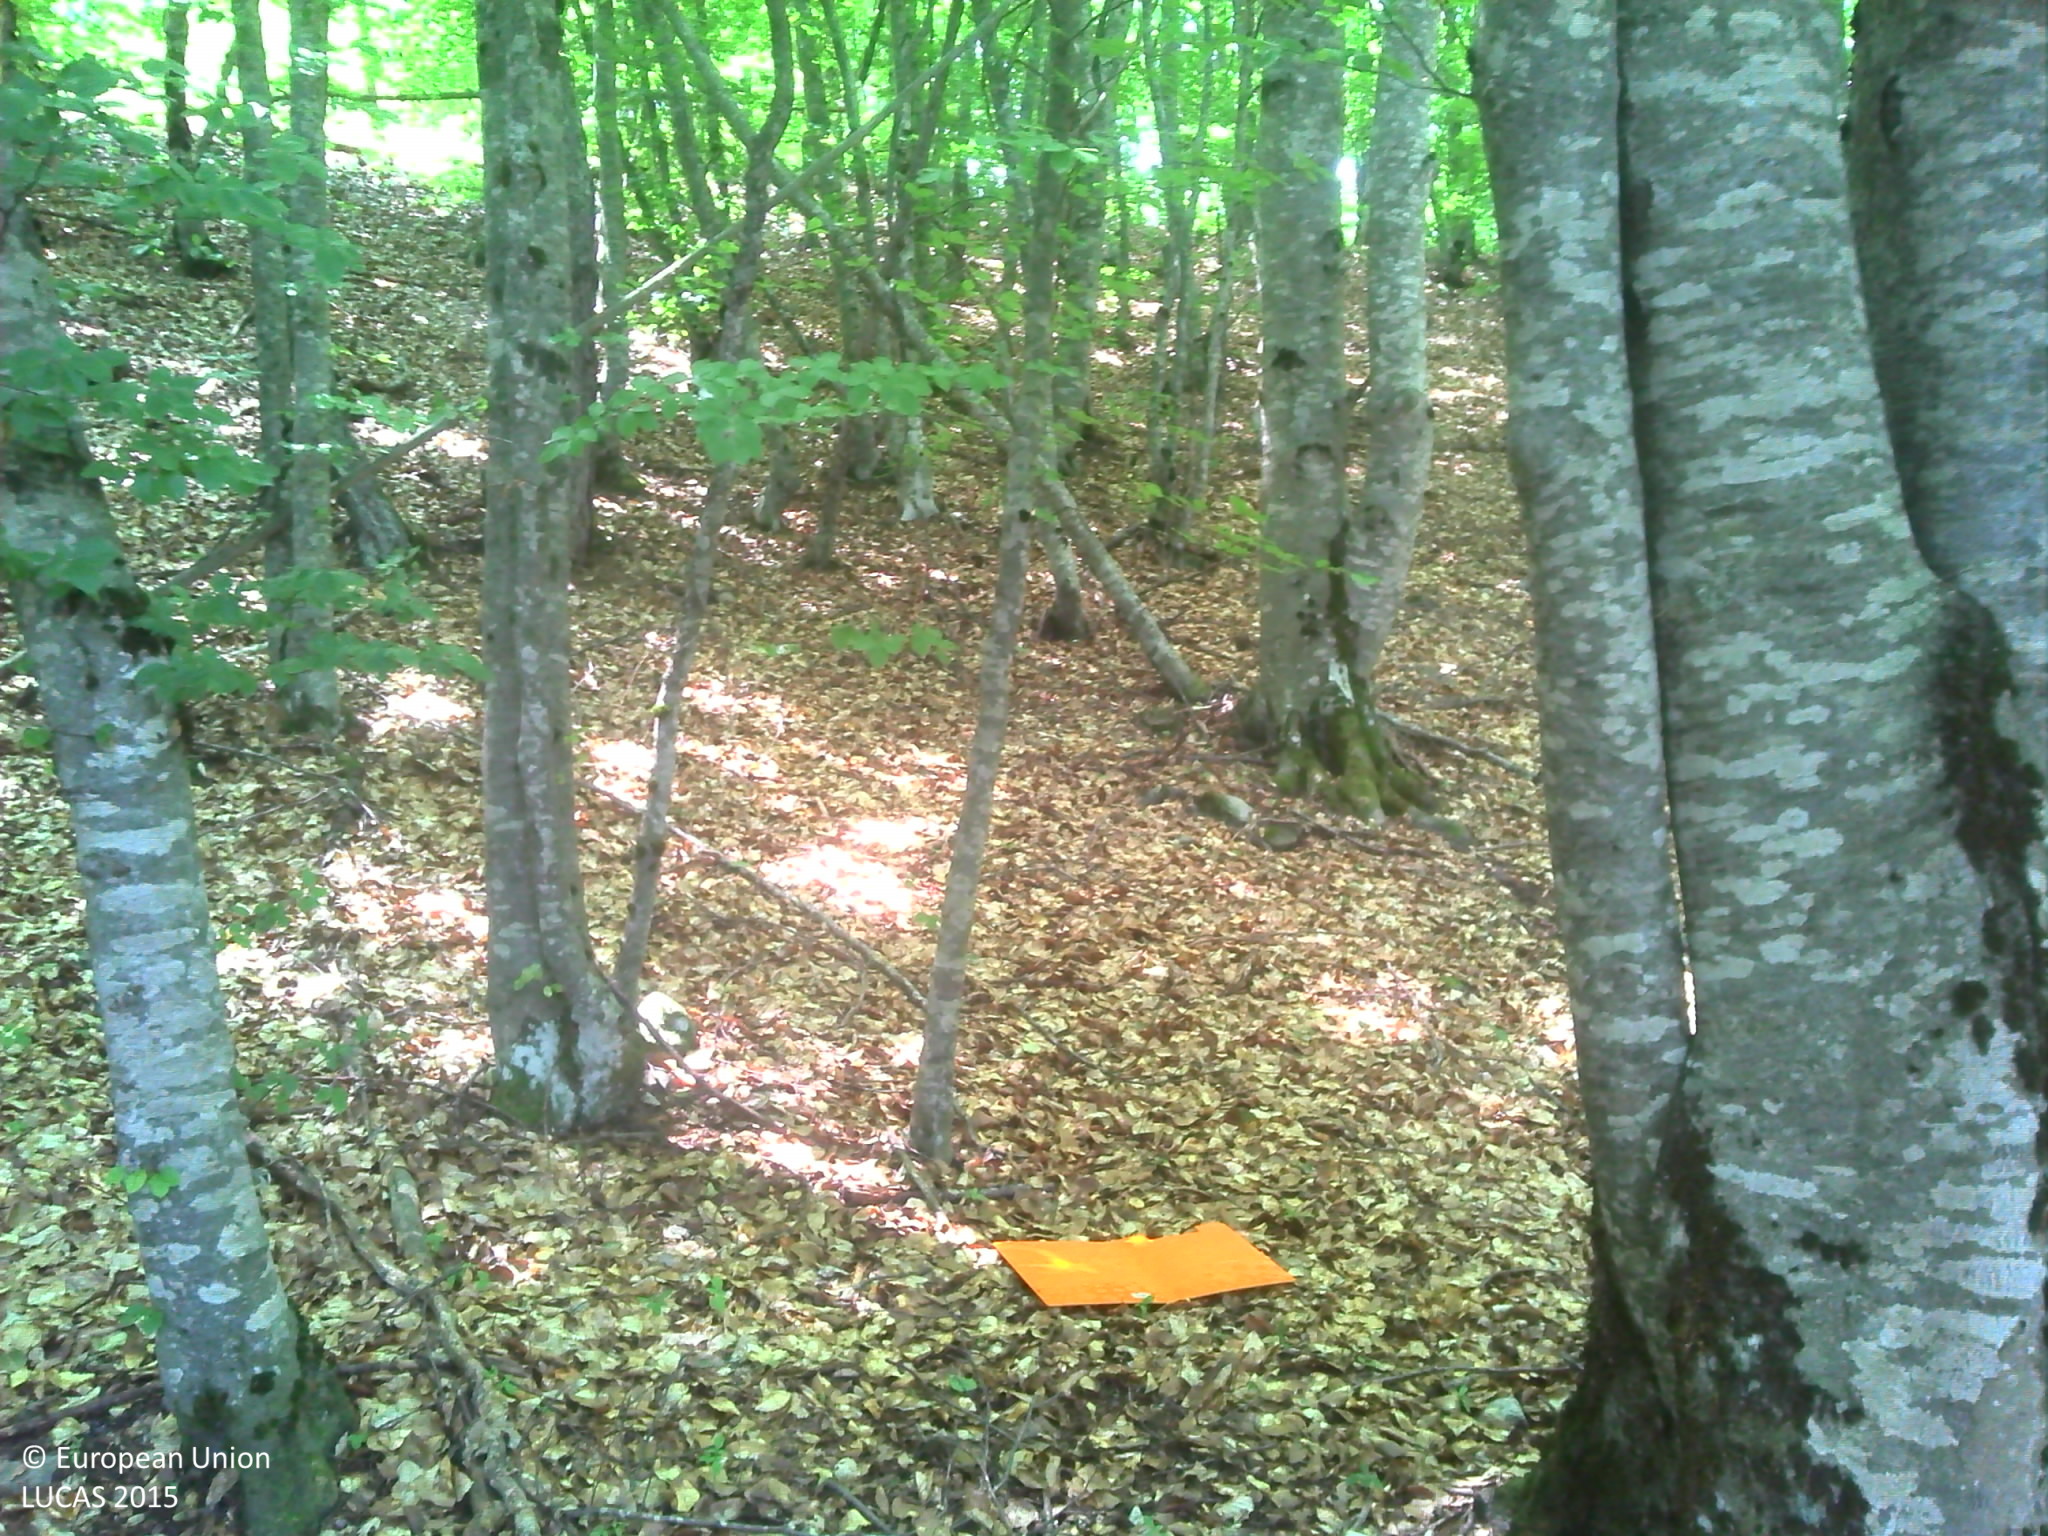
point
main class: Woodland
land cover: Broadleaved woodland
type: beech forest
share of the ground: > 75 %
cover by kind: broadleaved forest trees 85 %, shrubs 5 %, herbaceous plants 5 %, lichens and mosses 5 %
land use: Forestry
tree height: > 5 m
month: July
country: FR
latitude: 44.4291
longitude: 6.3010
